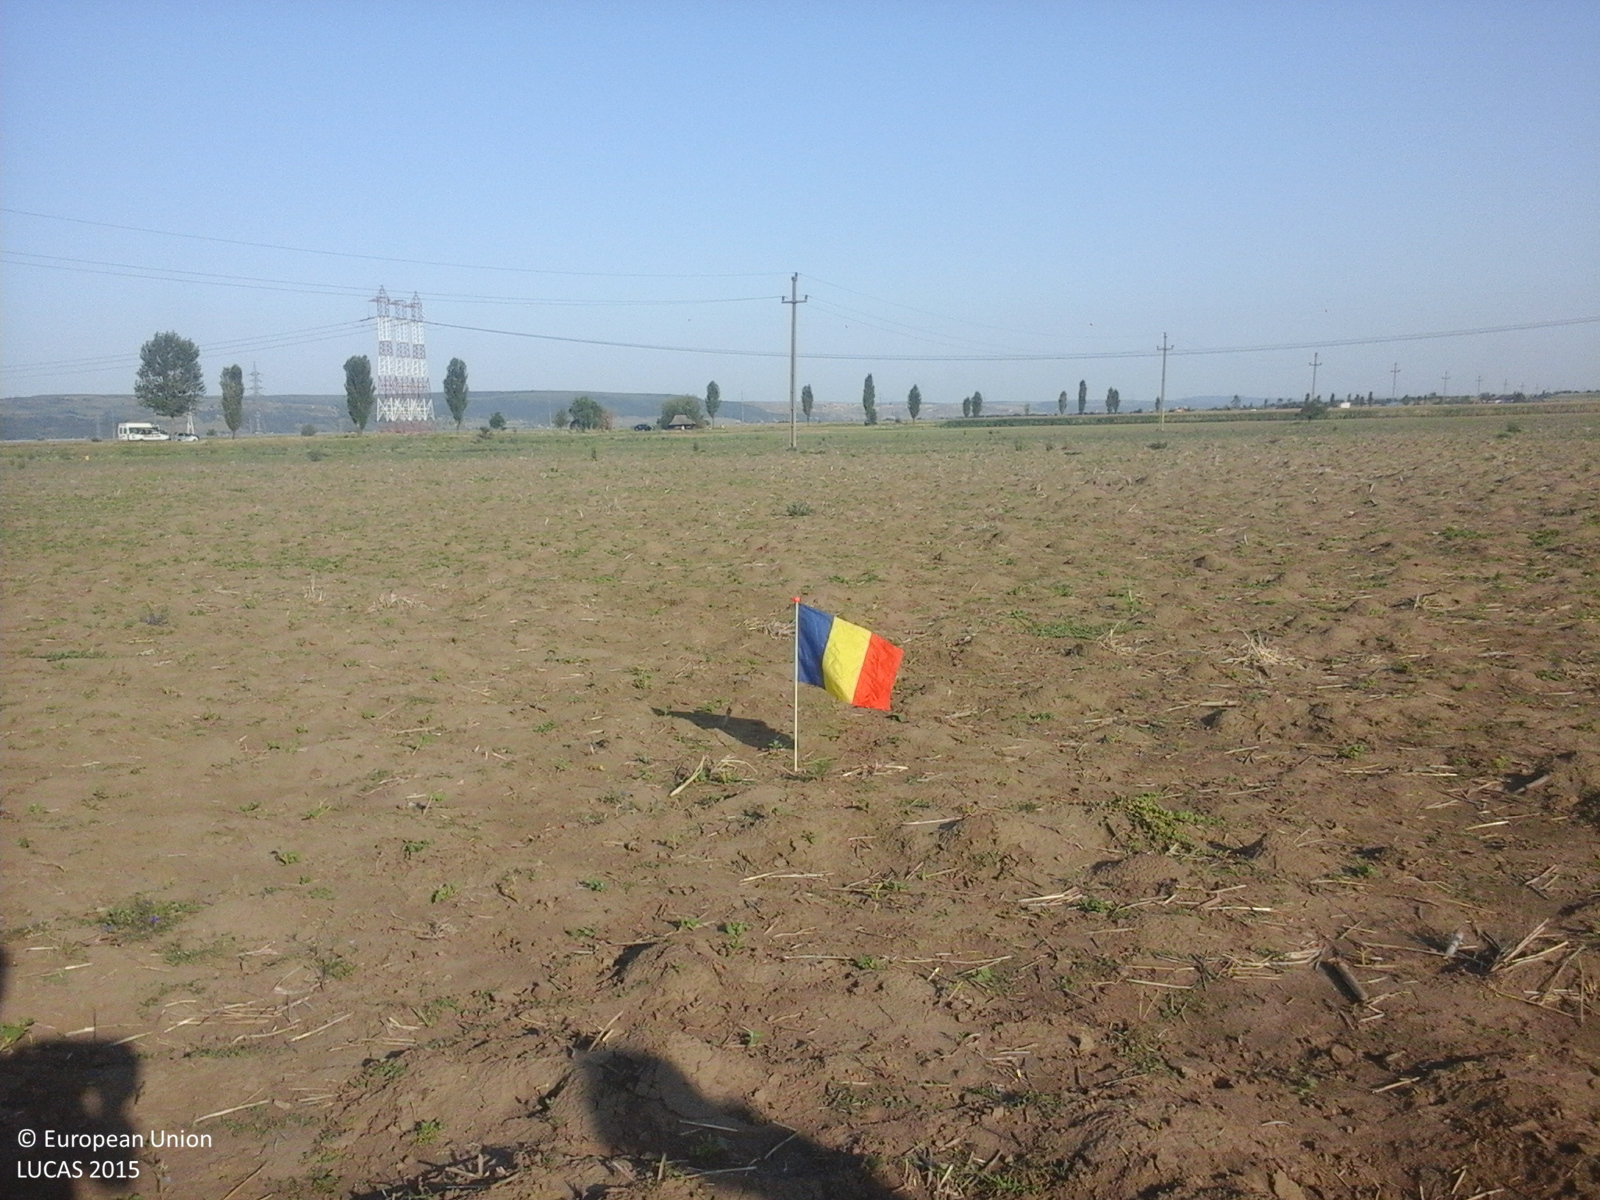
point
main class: Cropland
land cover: Common wheat
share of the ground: < 10 %
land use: Agriculture (excluding fallow land and kitchen gardens)
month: August
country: RO
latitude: 46.3173
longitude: 27.0169
